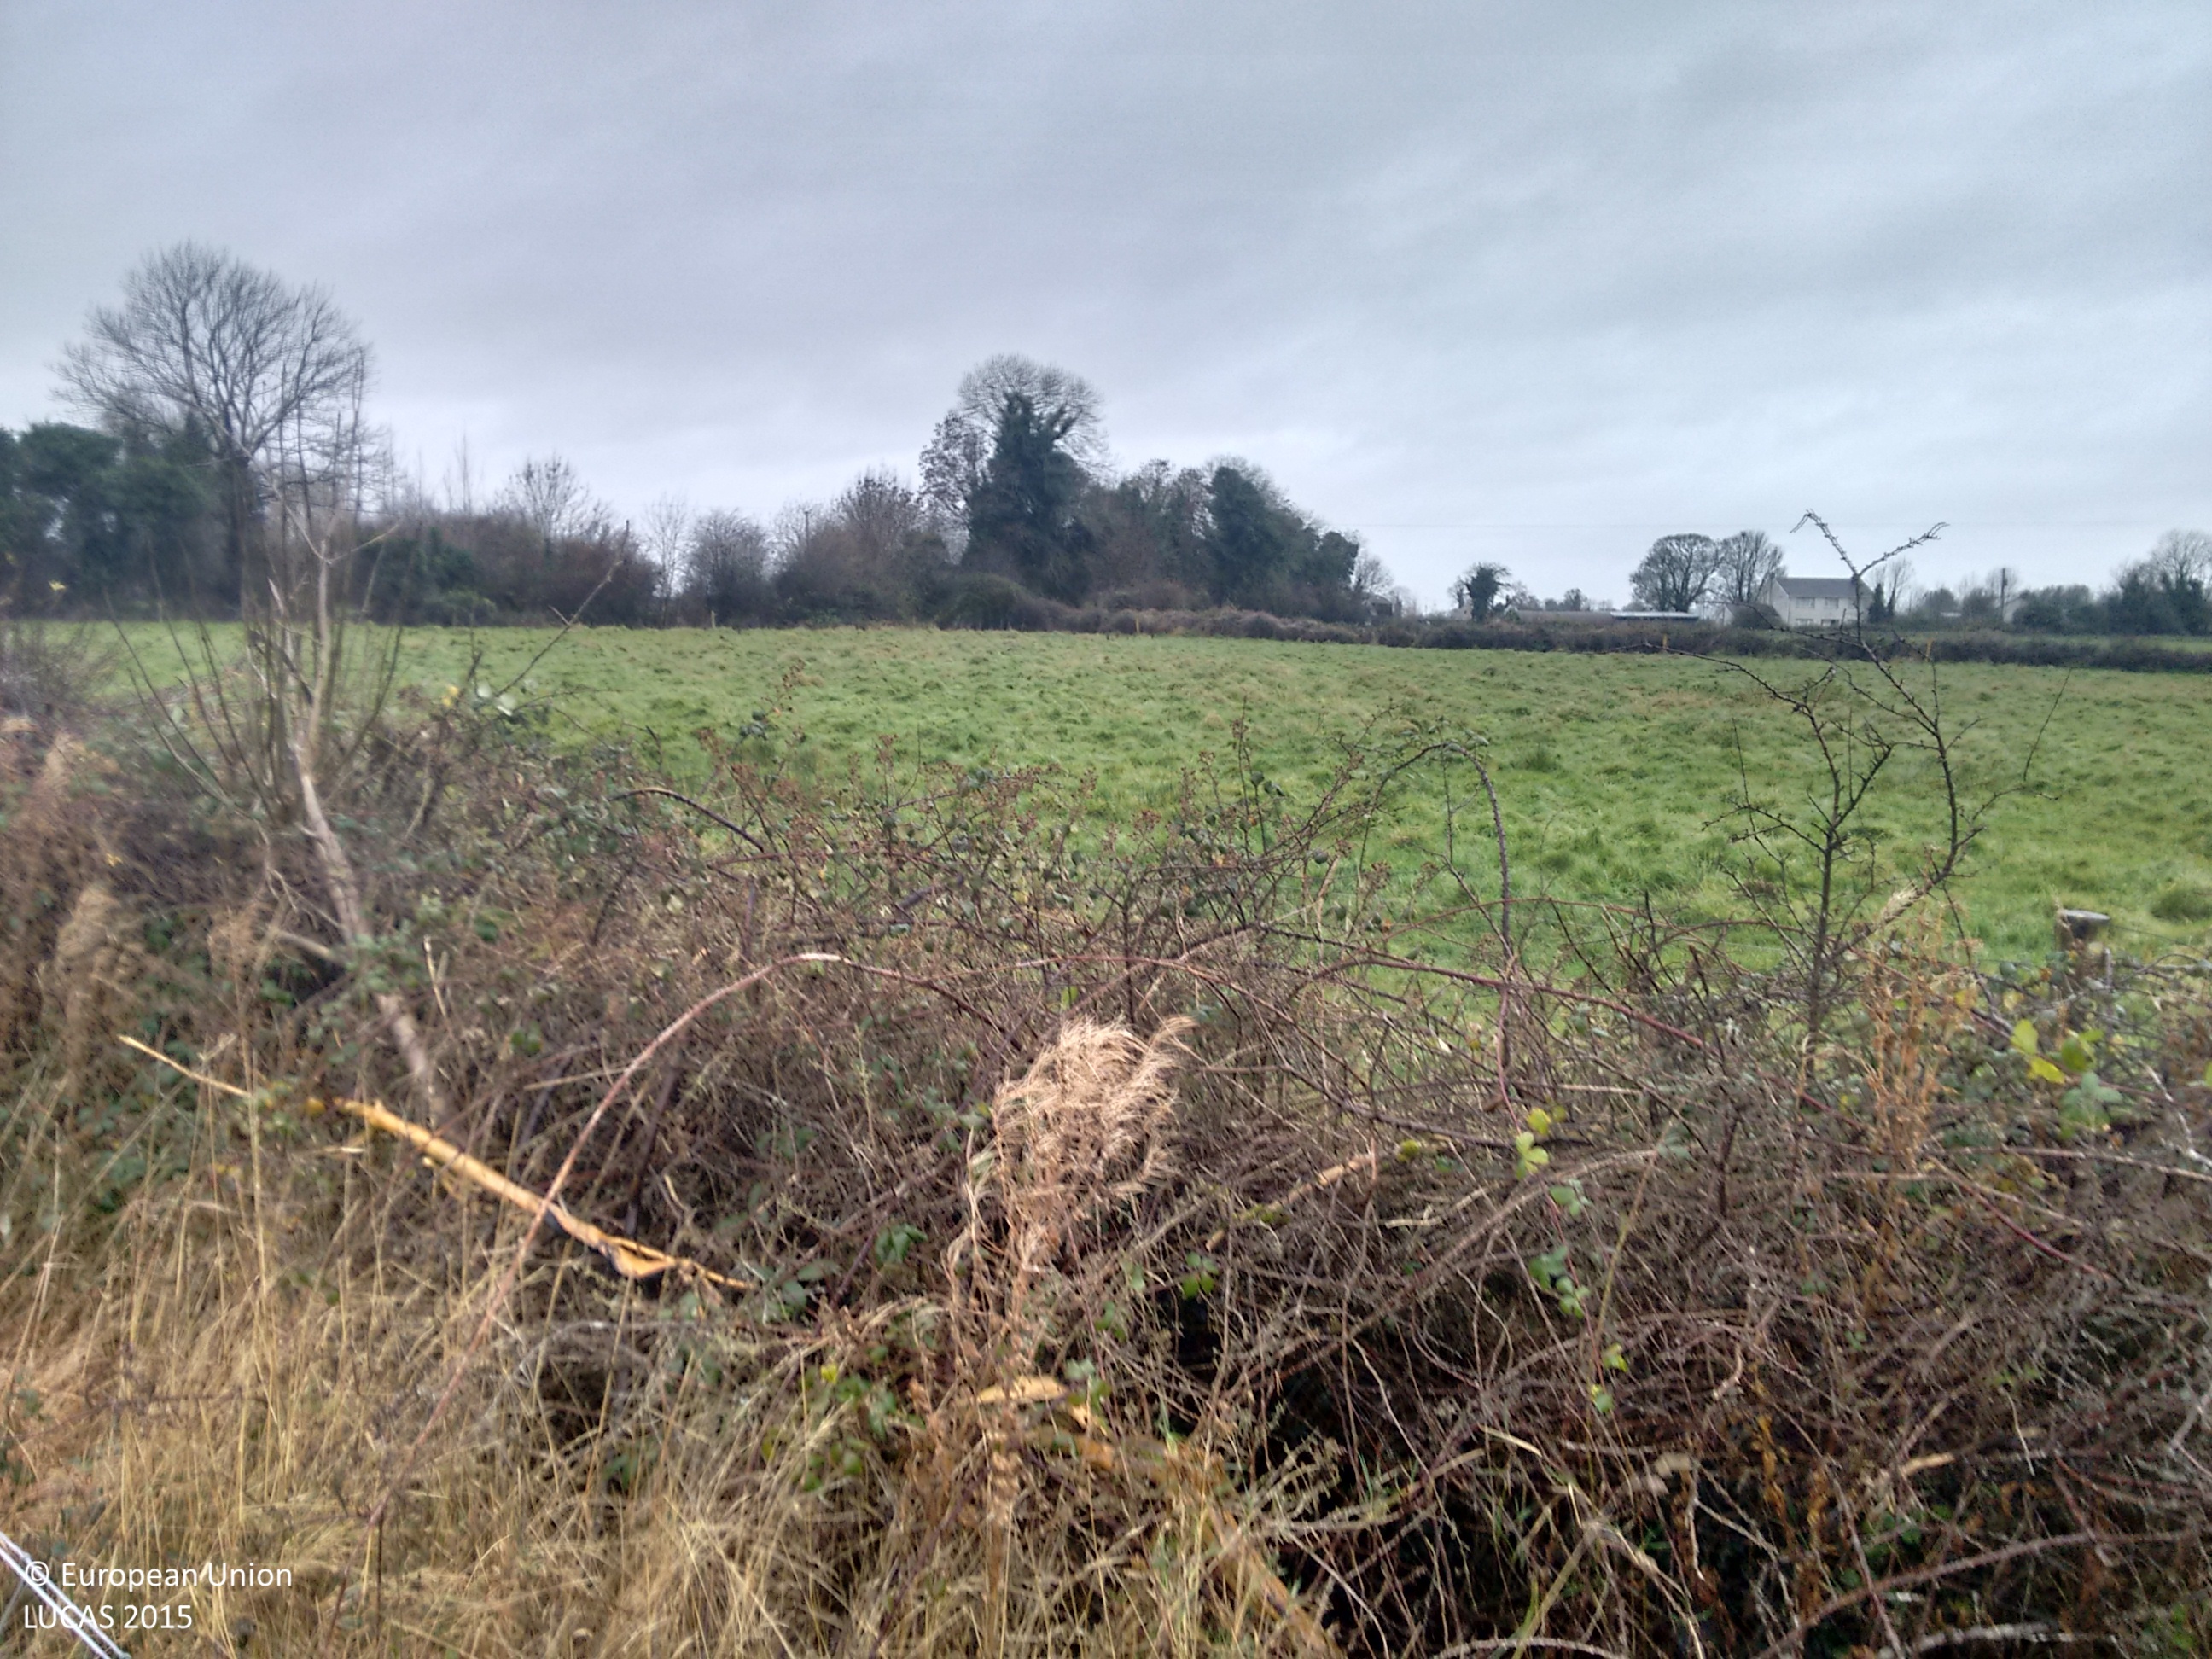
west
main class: Grassland
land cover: Grassland without tree/shrub cover
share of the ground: > 75 %
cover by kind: herbaceous plants 100 %
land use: Agriculture (excluding fallow land and kitchen gardens)
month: December
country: IE
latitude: 53.5847
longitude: -7.8900
